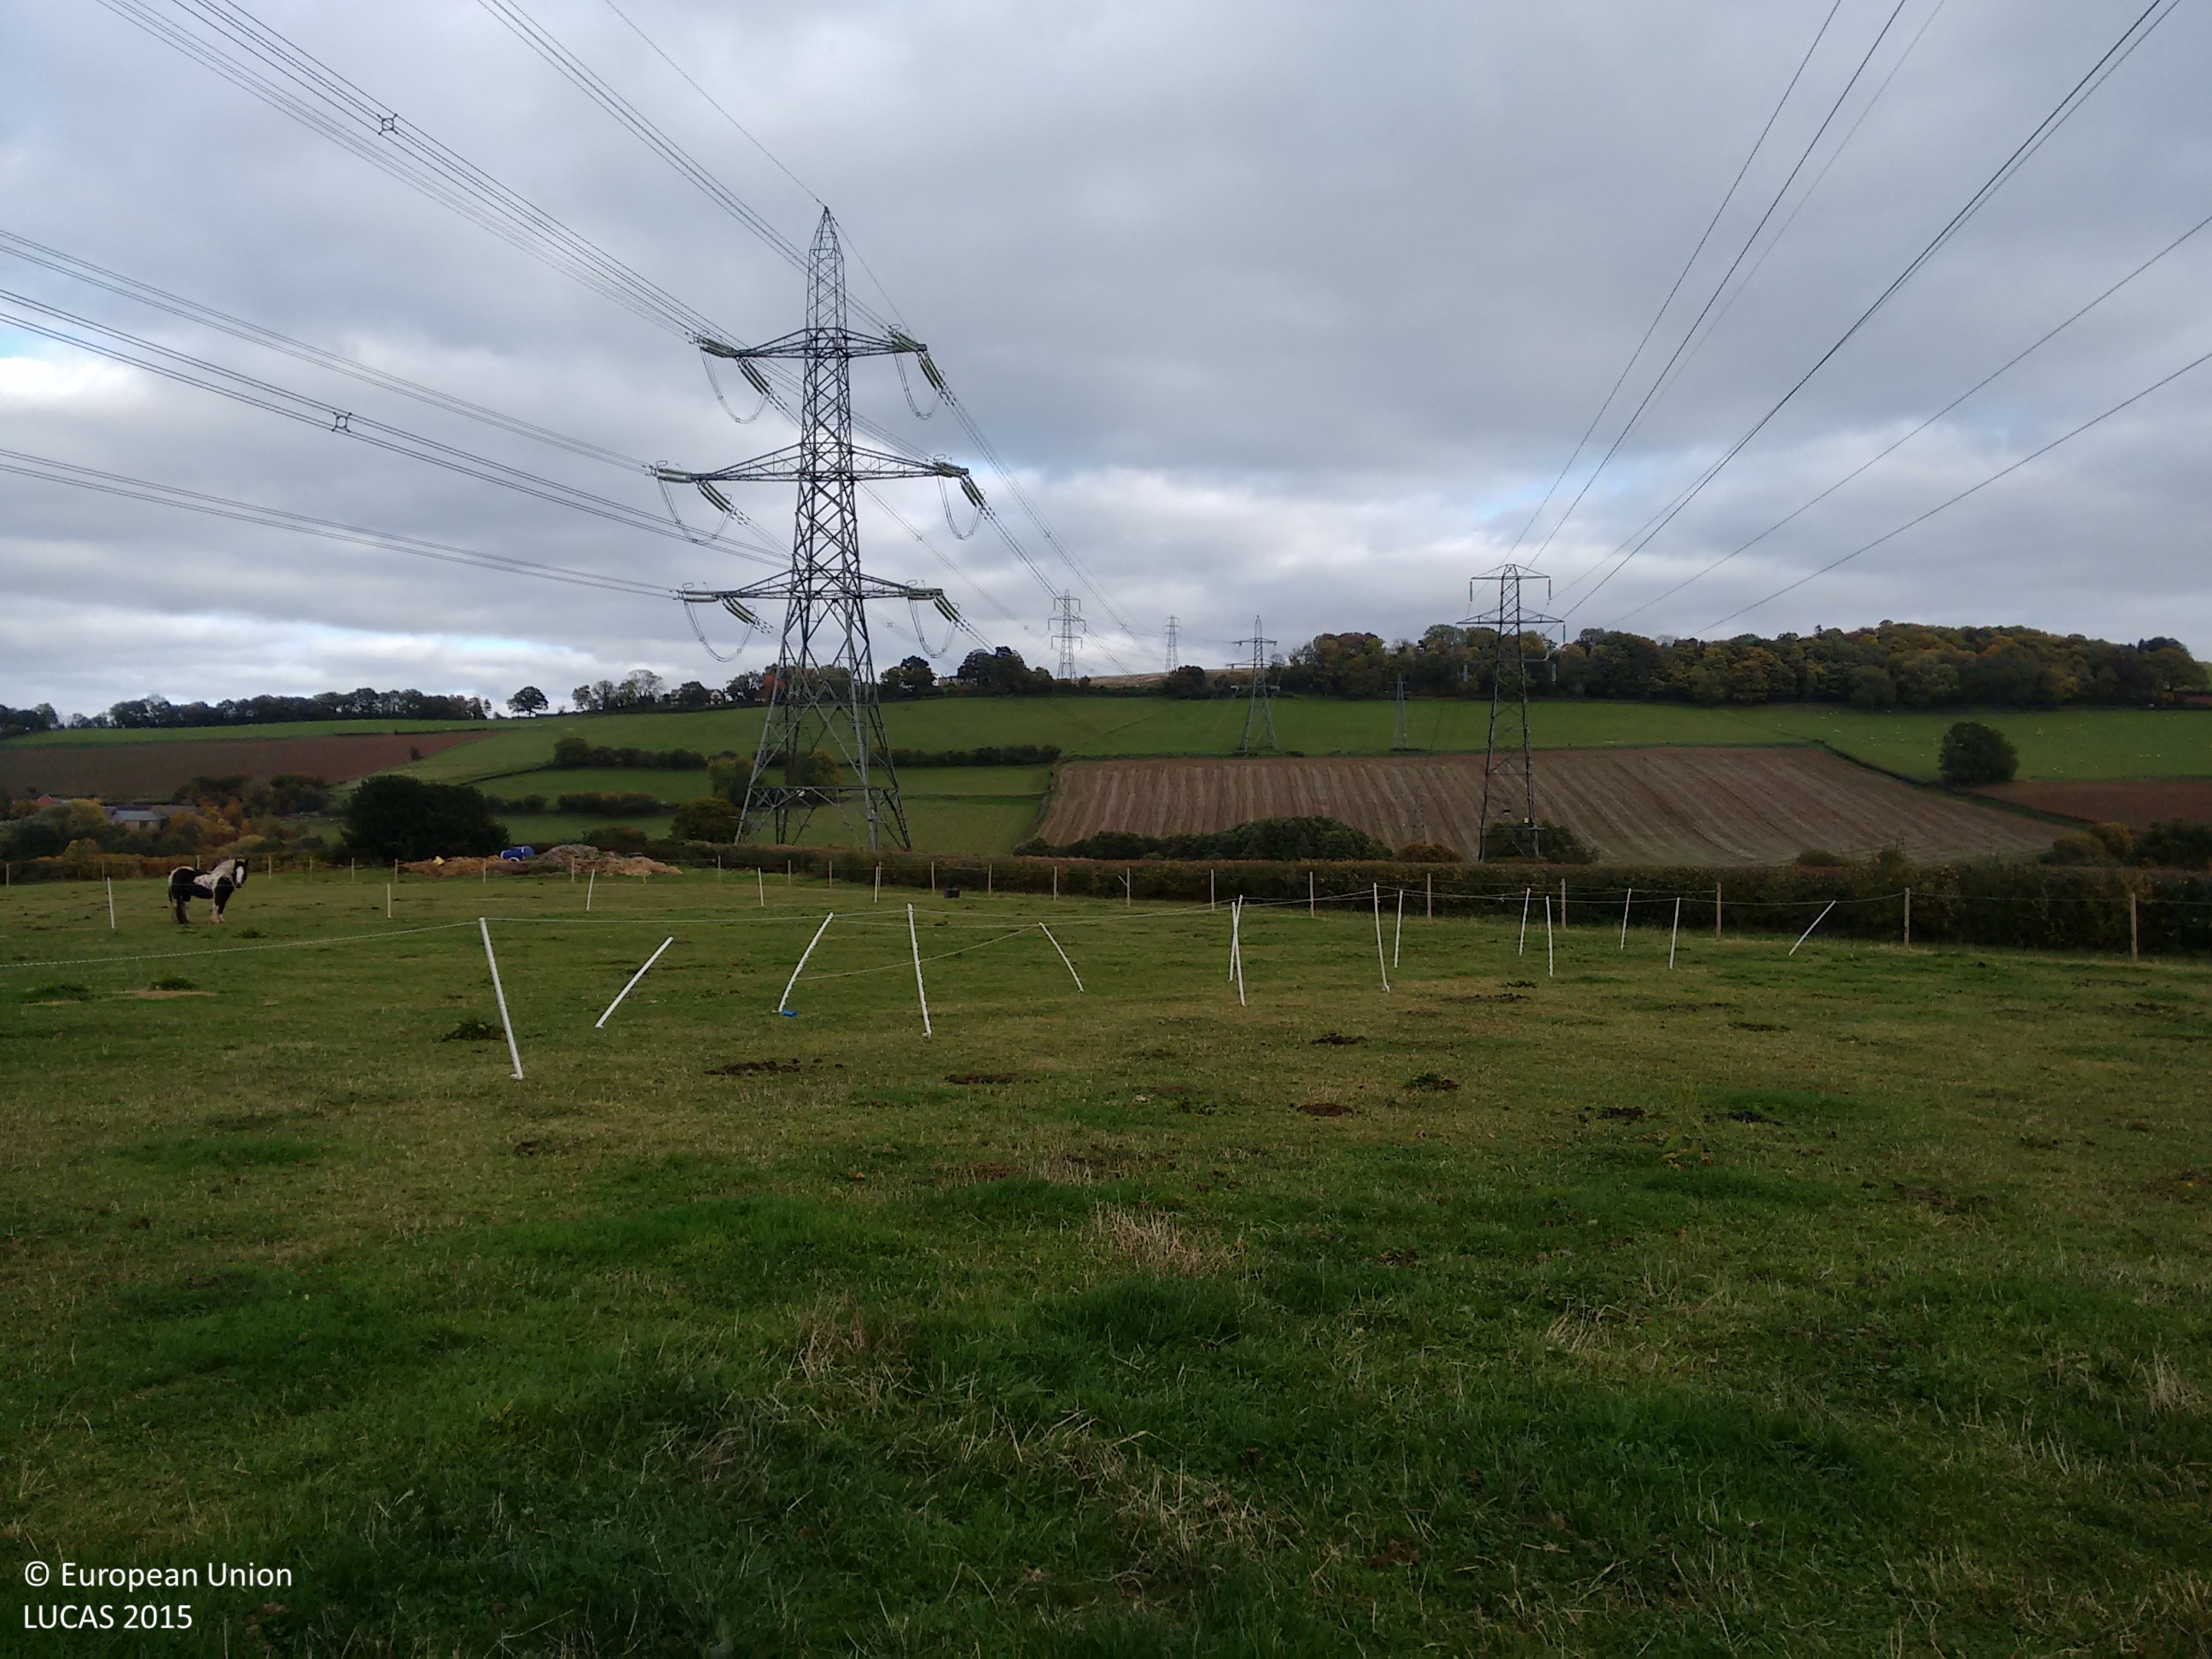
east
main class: Grassland
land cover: Grassland without tree/shrub cover
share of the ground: > 75 %
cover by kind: herbaceous plants 100 %
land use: Agriculture (excluding fallow land and kitchen gardens)
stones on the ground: < 10 %
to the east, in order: Grassland without tree/shrub cover; Fences; Grassland without tree/shrub cover; Fences; Grassland without tree/shrub cover; Tracks; Managed hedges; Fences; Managed hedges; Spontaneously vegetated surfaces
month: October
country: GB
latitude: 51.8965
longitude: -2.4914
